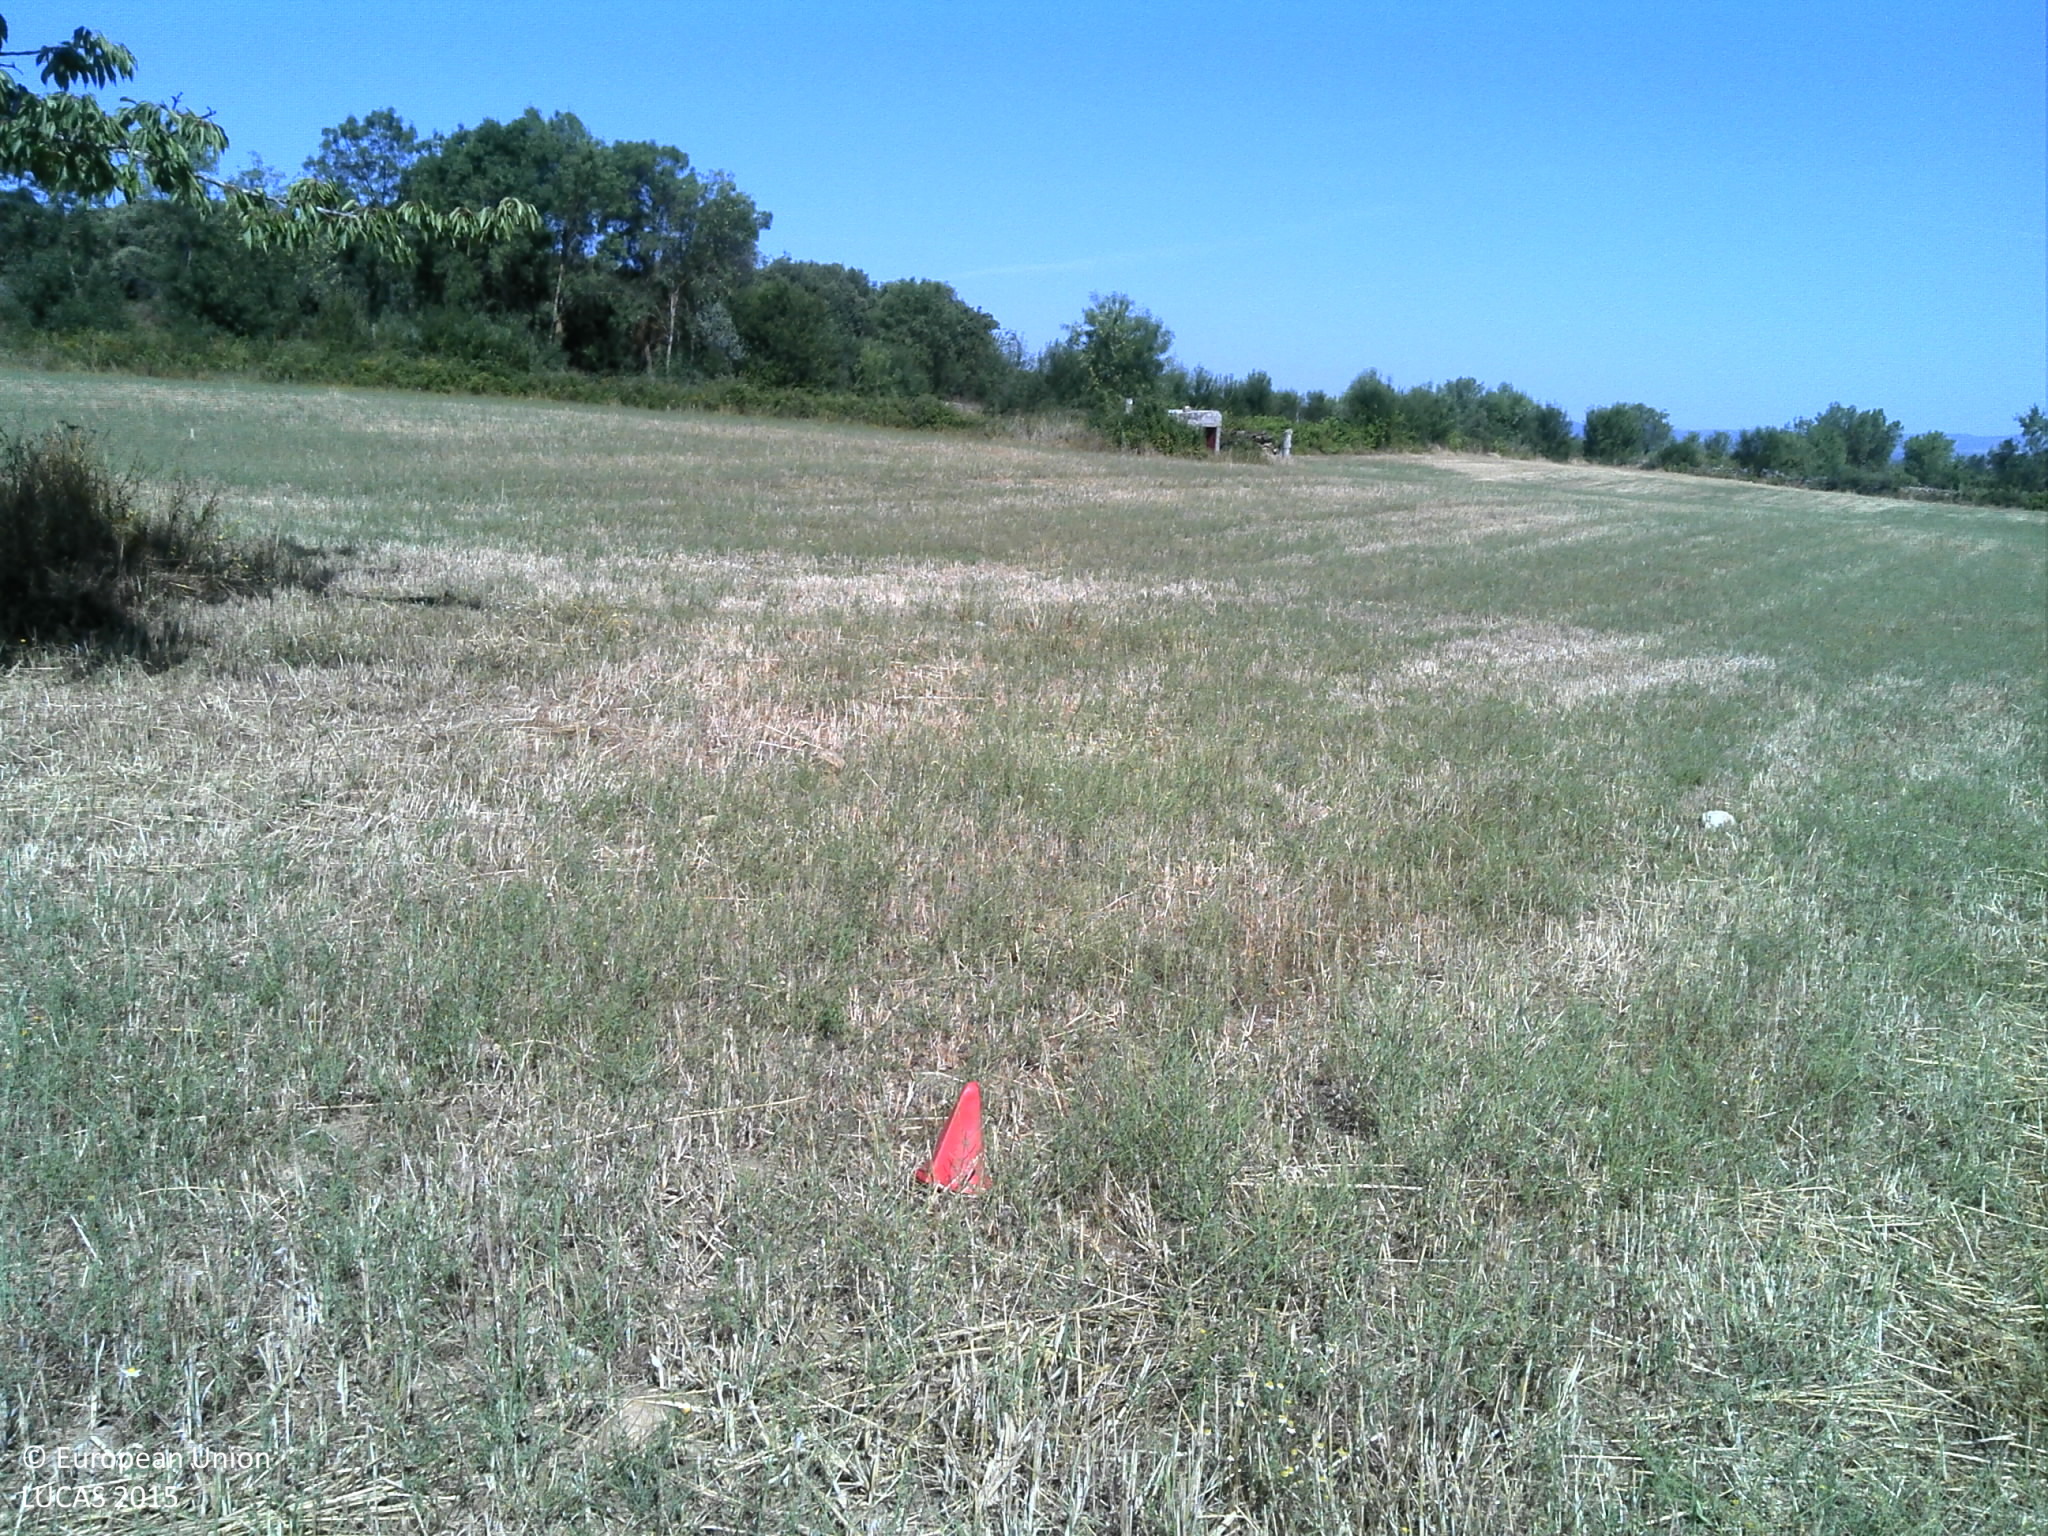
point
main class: Cropland
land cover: Oats
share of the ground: > 75 %
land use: Agriculture (excluding fallow land and kitchen gardens)
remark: Harvested field
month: June
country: PT
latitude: 40.8801
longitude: -7.0645
